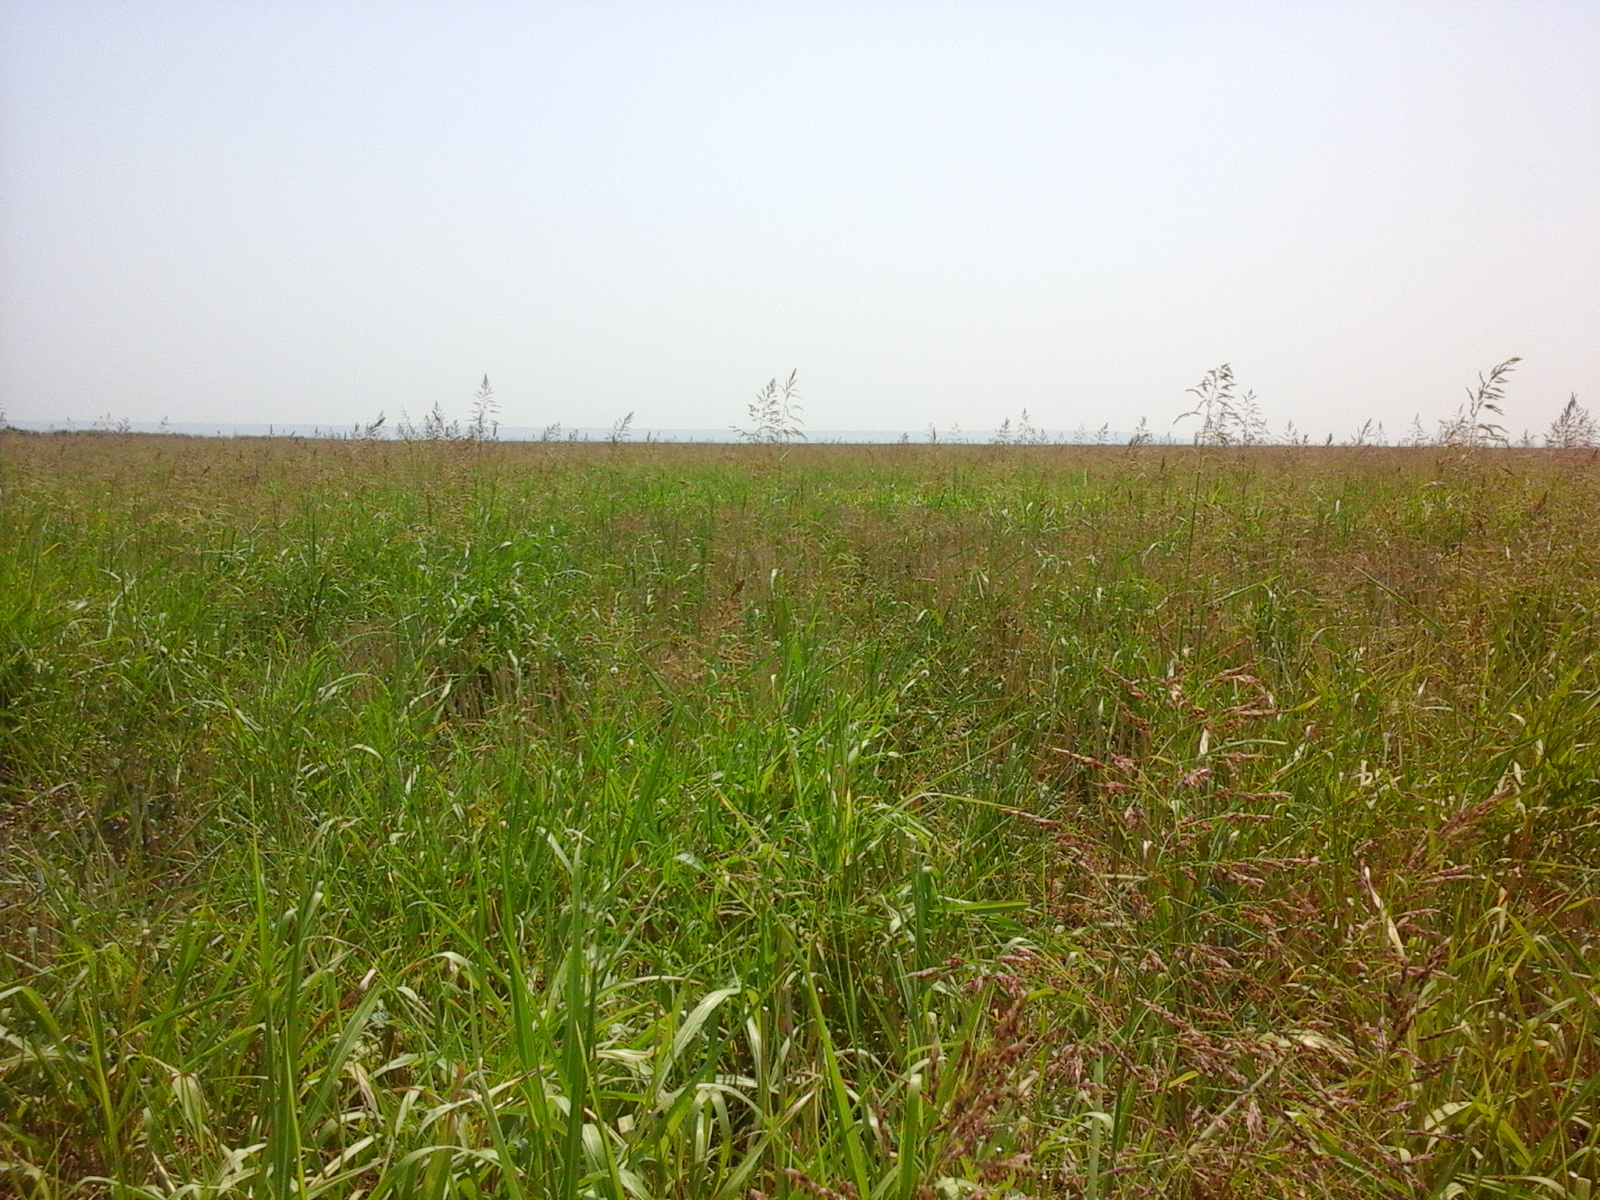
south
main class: Cropland
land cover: Rape and turnip rape
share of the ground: 10 - 25 %
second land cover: Spontaneously vegetated surfaces
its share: > 75 %
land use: Agriculture (excluding fallow land and kitchen gardens)
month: August
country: RO
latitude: 43.9415
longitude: 23.3394
